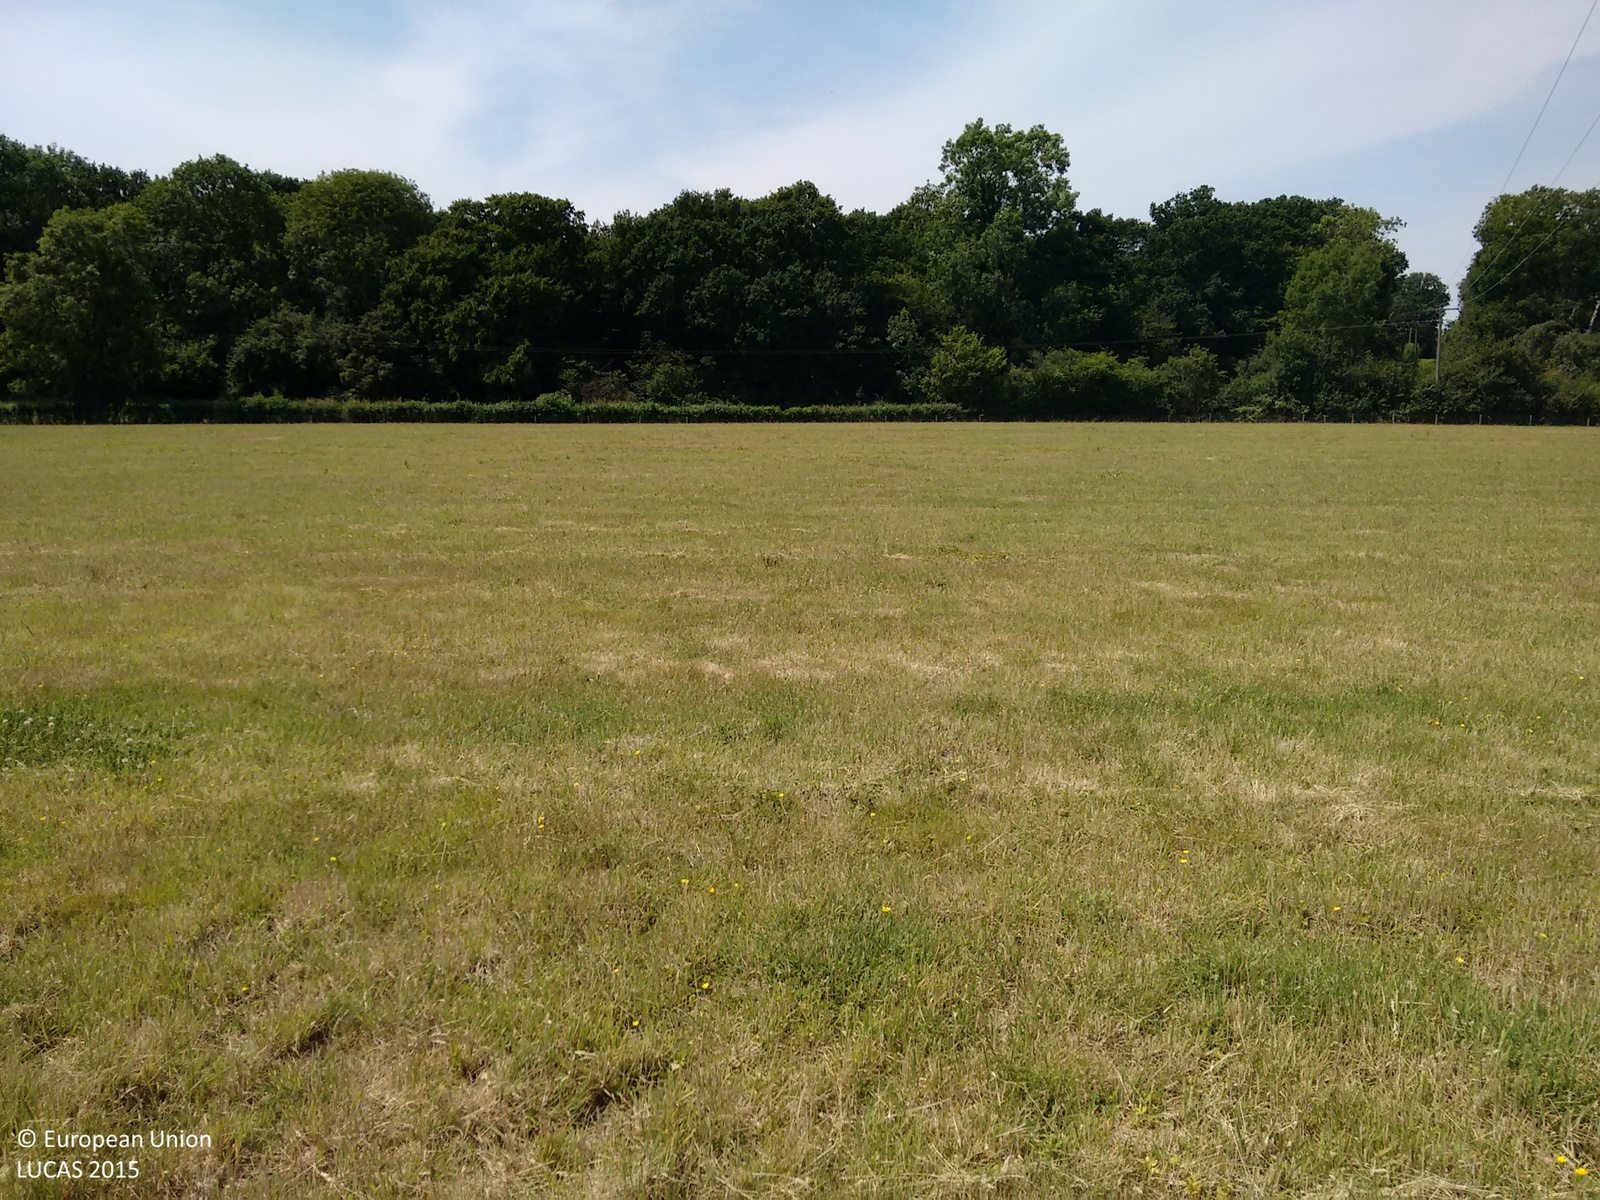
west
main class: Grassland
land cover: Grassland without tree/shrub cover
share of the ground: > 75 %
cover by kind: herbaceous plants 100 %
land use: Agriculture (excluding fallow land and kitchen gardens)
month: July
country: GB
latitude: 50.9240
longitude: -0.3795
